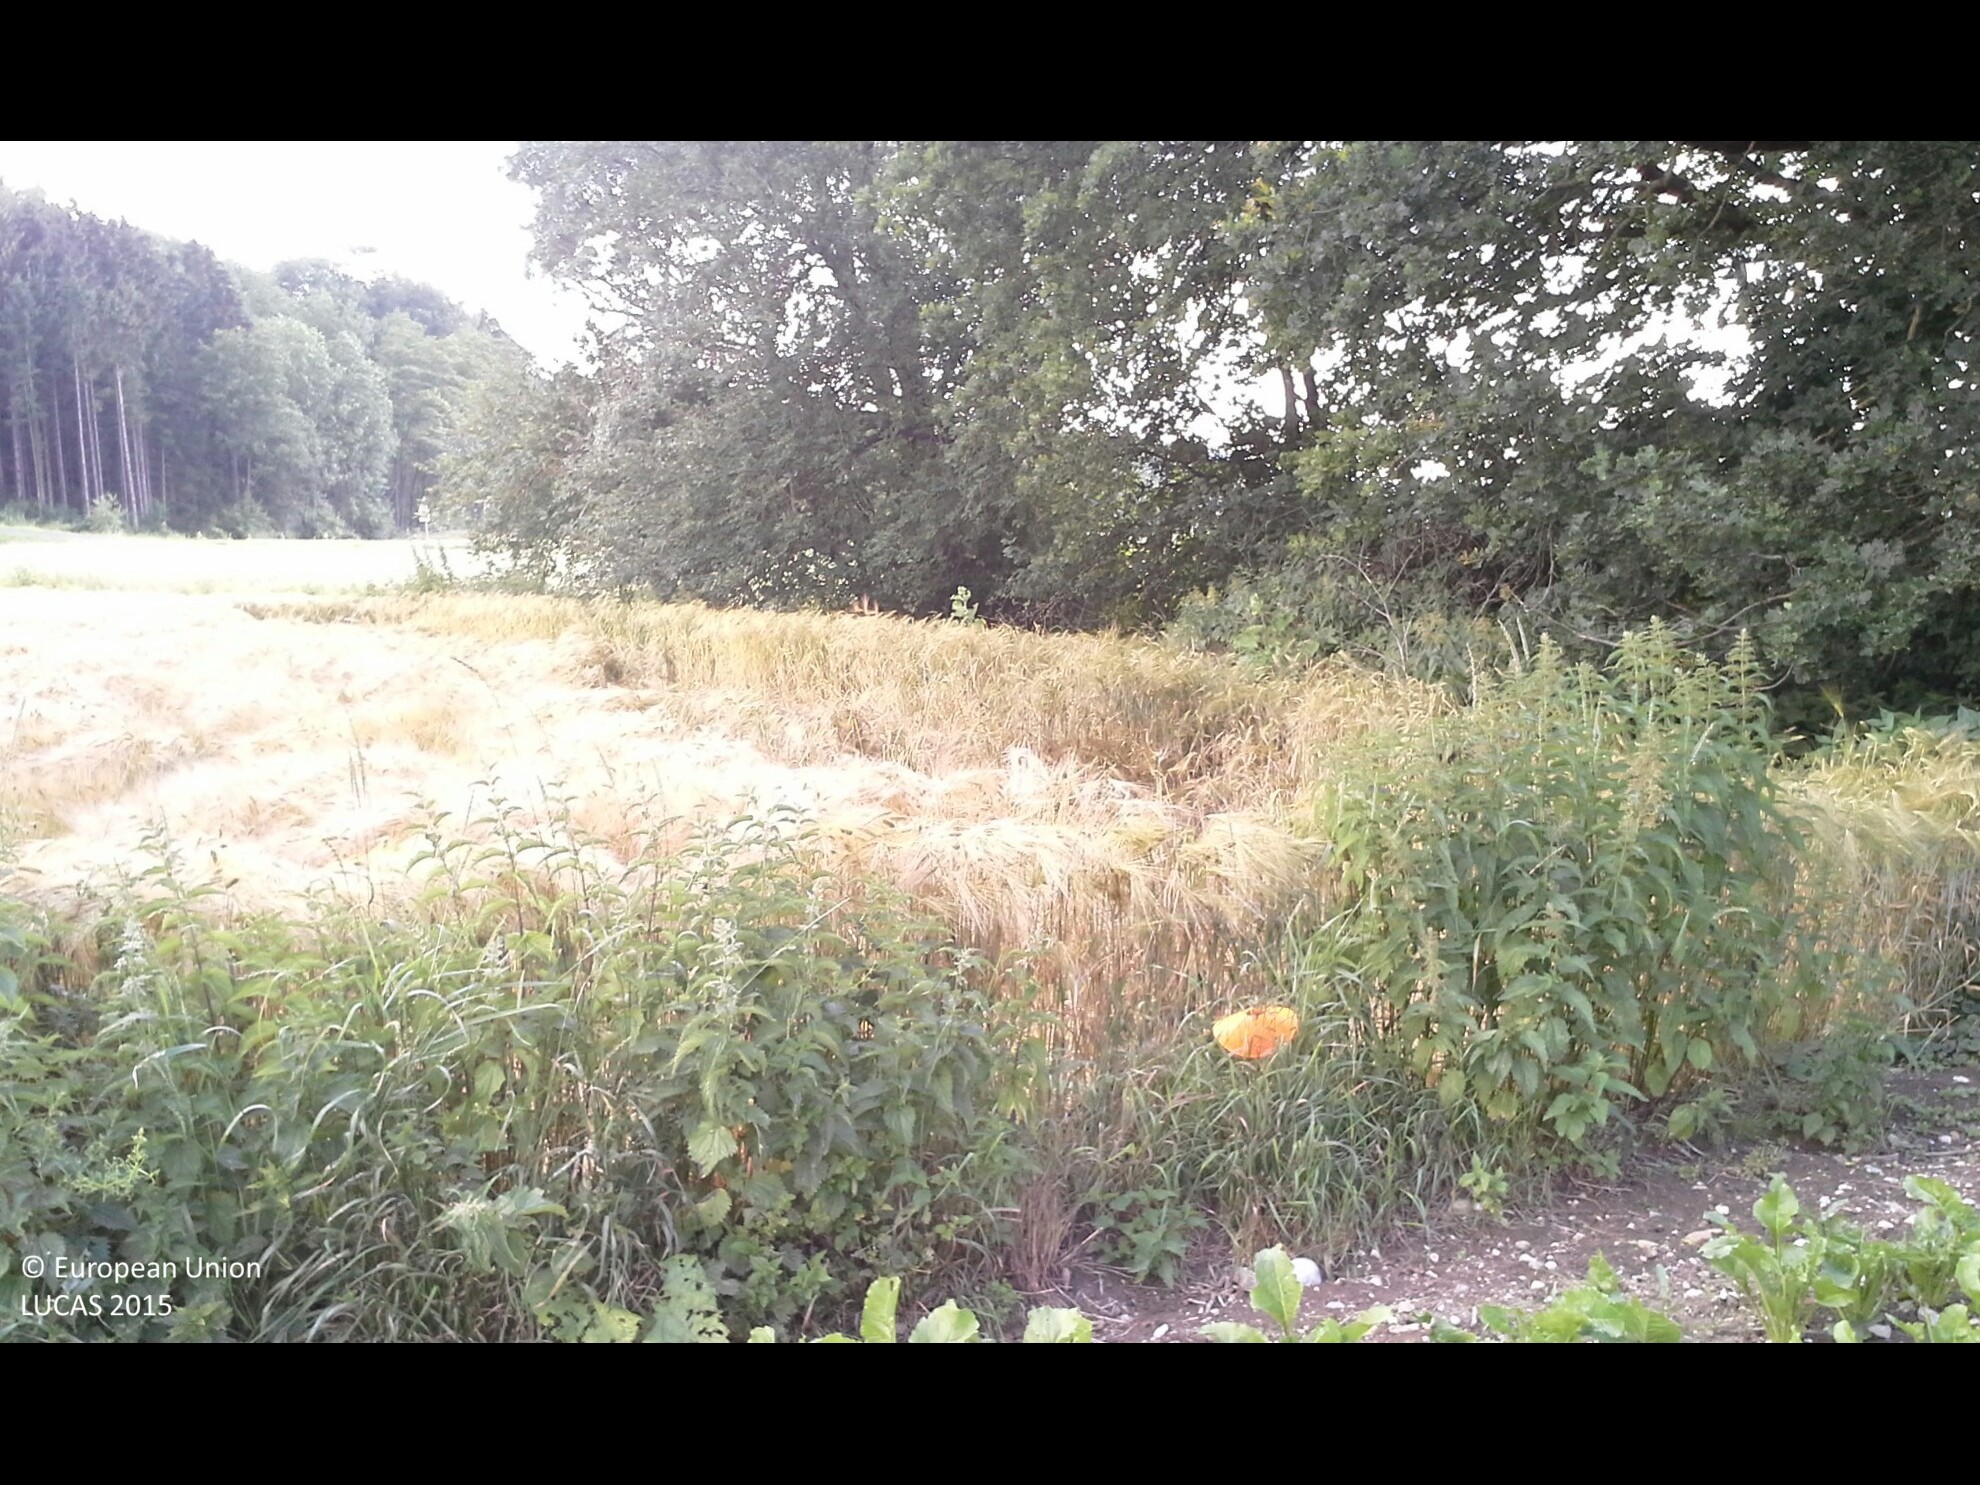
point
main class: Cropland
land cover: Sugar beet
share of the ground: > 75 %
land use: Agriculture (excluding fallow land and kitchen gardens)
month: June
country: AT
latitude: 48.0520
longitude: 14.6826
